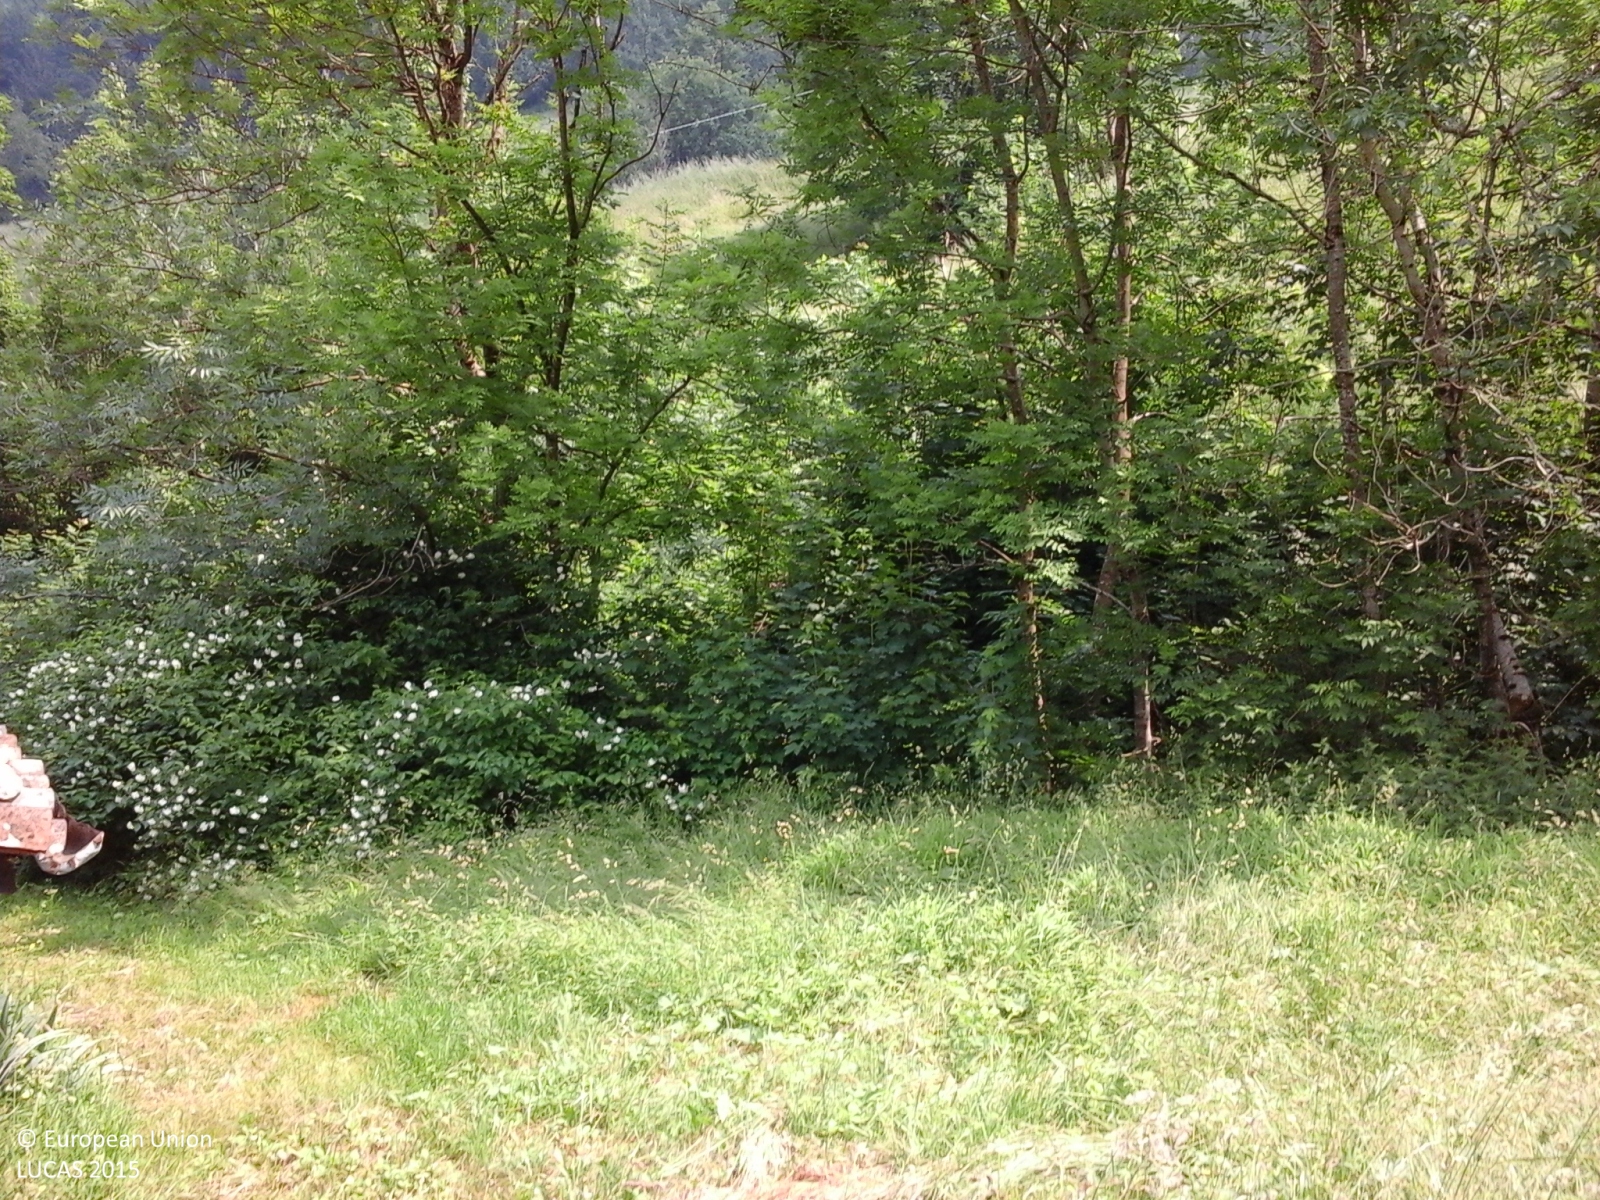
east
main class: Grassland
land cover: Grassland without tree/shrub cover
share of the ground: > 75 %
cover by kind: herbaceous plants 100 %
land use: Agriculture (excluding fallow land and kitchen gardens)
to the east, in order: Grassland without tree/shrub cover; Broadleaved woodland; Ditches and canals; Shrubland without tree cover; Tracks; Grassland without tree/shrub cover; Electric lines; Grassland without tree/shrub cover; Abandoned hedges; Grassland without tree/shrub cover; Broadleaved woodland; Grassland without tree/shrub cover; Broadleaved woodland
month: June
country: IT
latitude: 45.7565
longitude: 10.2182
